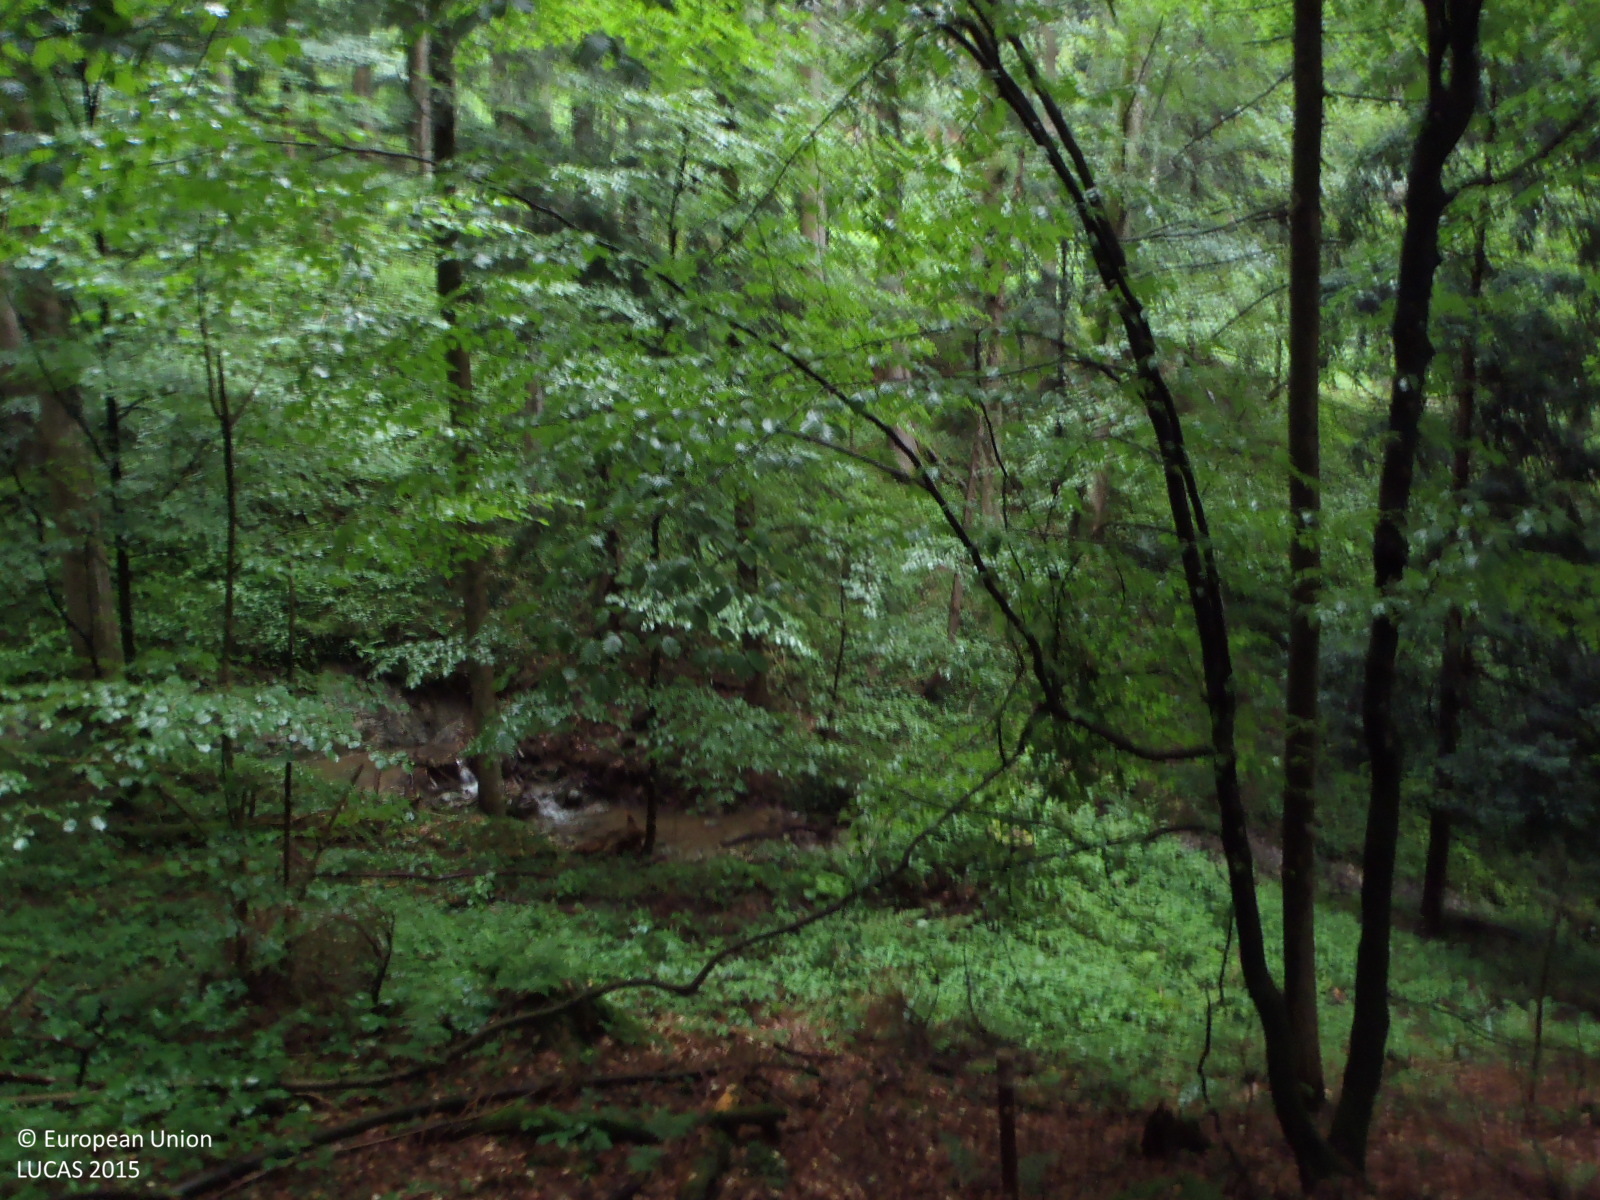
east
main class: Woodland
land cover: Broadleaved woodland
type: mountainous beech forest
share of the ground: > 75 %
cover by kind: broadleaved forest trees 80 %, coniferous forest trees 20 %
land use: Forestry
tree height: > 5 m
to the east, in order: Broadleaved woodland; Rivers and streams; Other mixed woodland; Tracks; Shrubland with sparse tree cover; Other mixed woodland; Grassland without tree/shrub cover
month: July
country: AT
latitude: 47.6610
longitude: 12.2223
